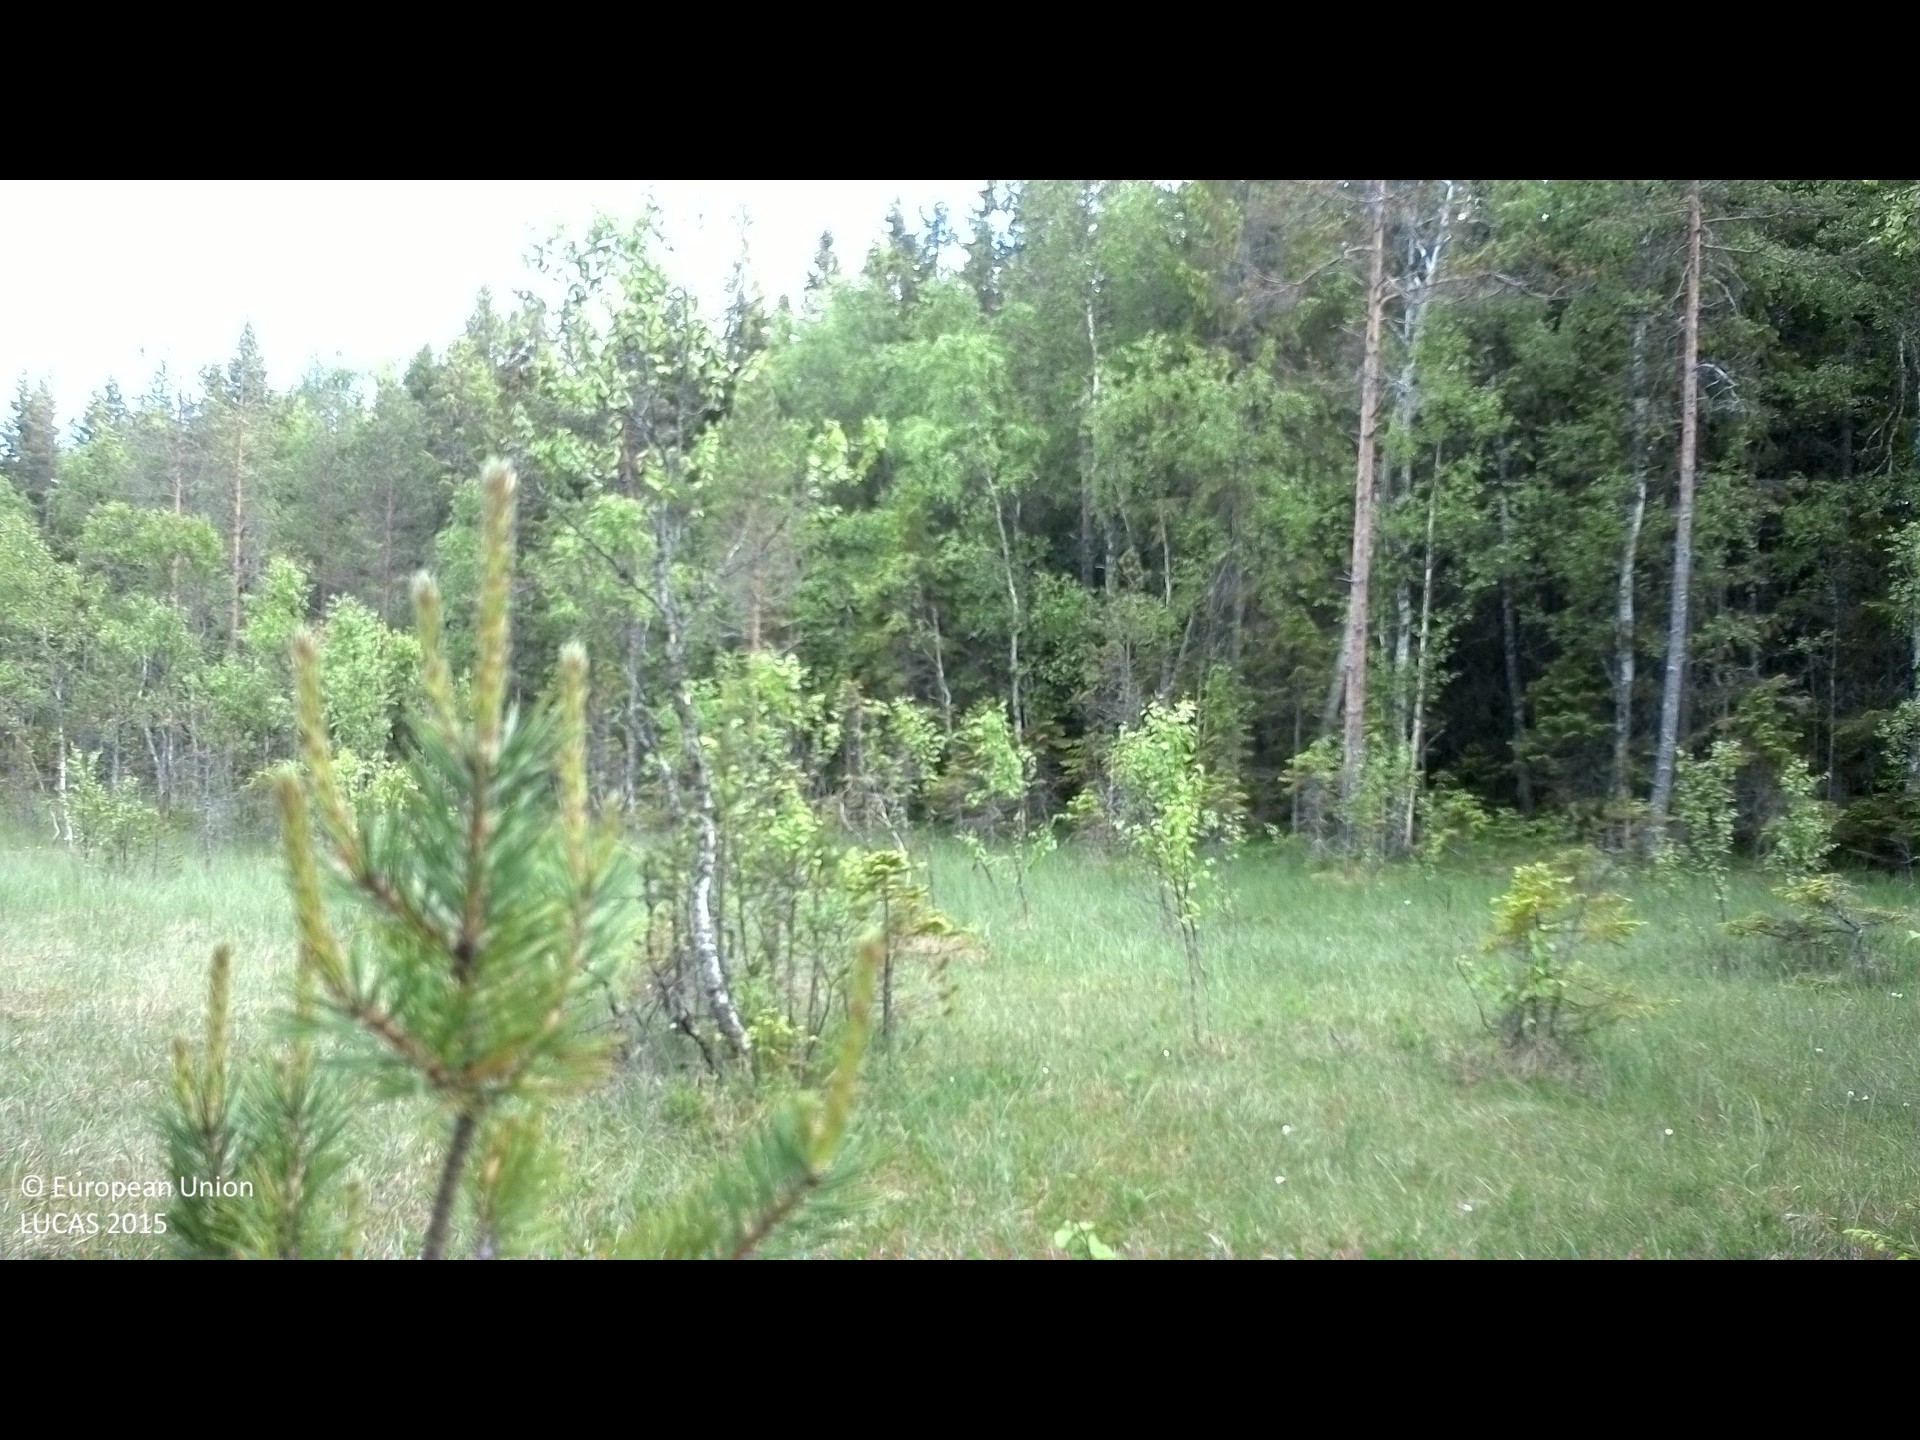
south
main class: Woodland
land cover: Pine dominated coniferous woodland
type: boreal forest
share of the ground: 50 - 75 %
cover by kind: lichens and mosses 55 %, coniferous forest trees 40 %, broadleaved forest trees 5 %
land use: Semi-natural and natural areas not in use
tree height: > 5 m
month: June
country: SE
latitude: 61.9507
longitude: 16.8258
